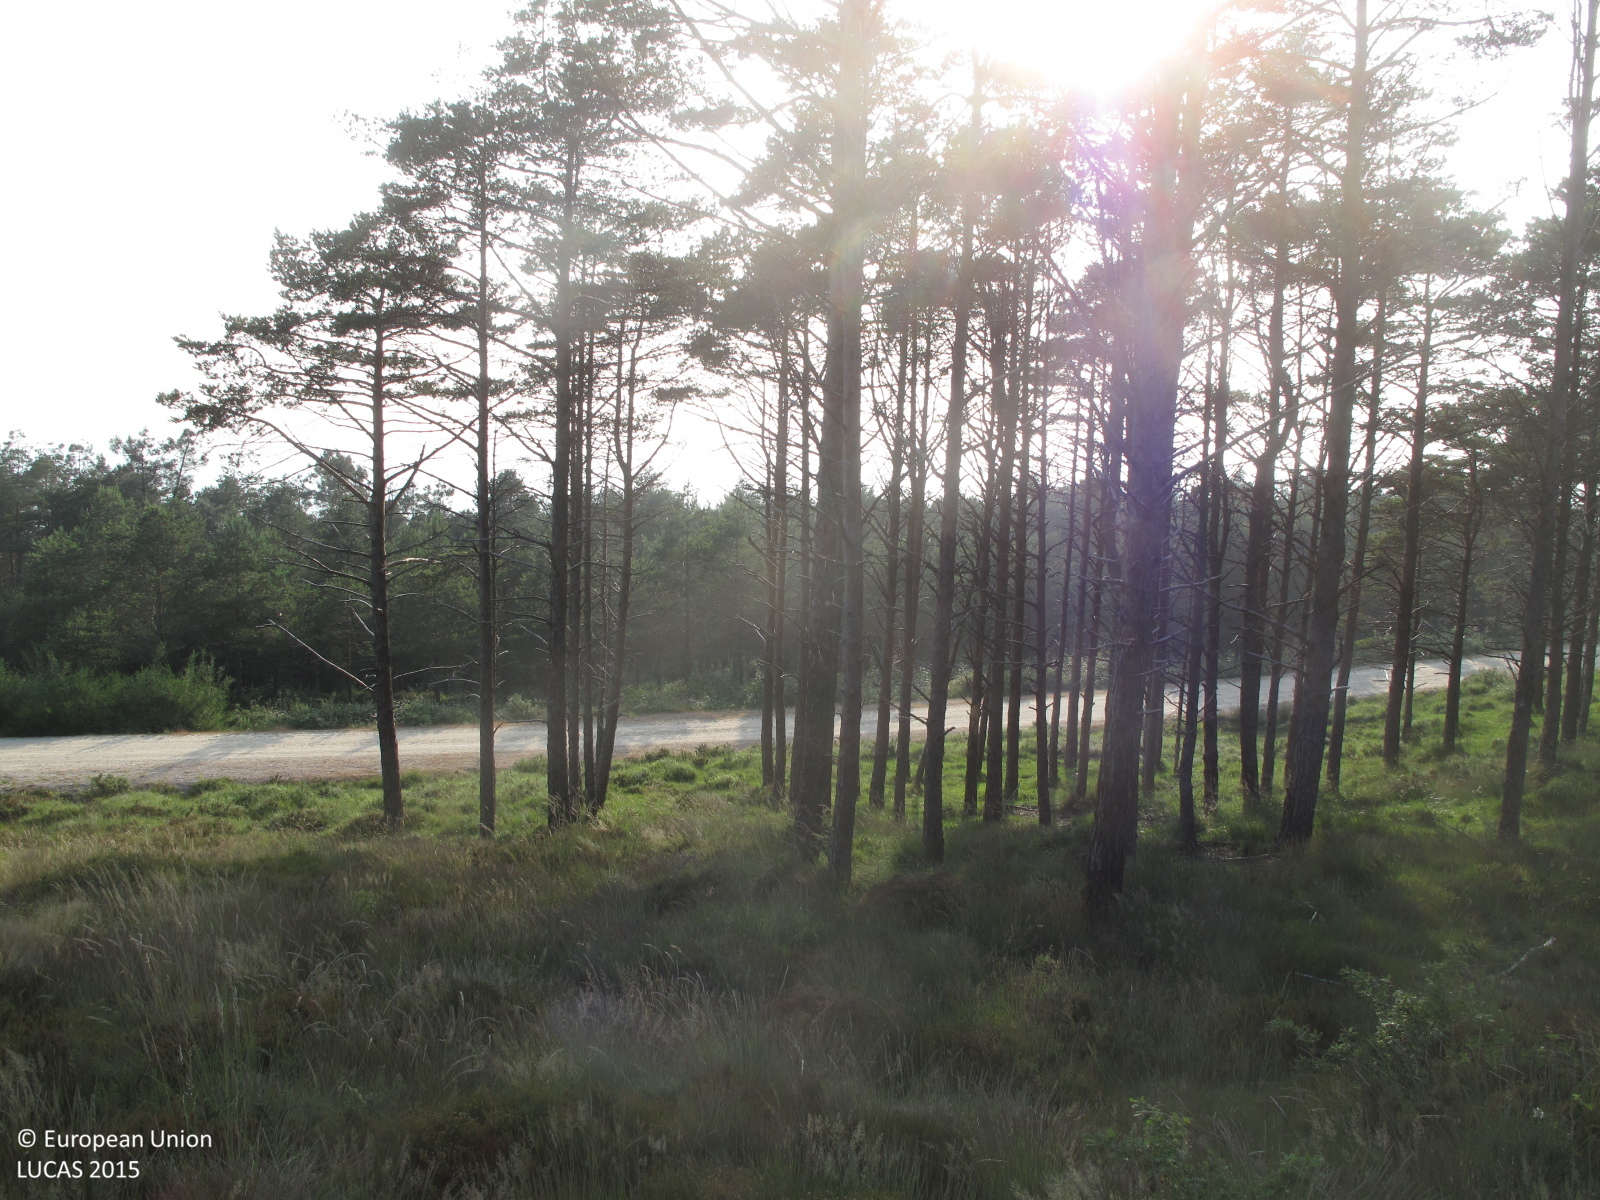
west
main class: Shrubland
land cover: Shrubland with sparse tree cover
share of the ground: 25 - 50 %
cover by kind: herbaceous plants 50 %, shrubs 45 %, broadleaved forest trees 5 %
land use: Semi-natural and natural areas not in use
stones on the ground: 10 - 25 %
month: June
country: ES
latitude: 43.0896
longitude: -7.9134
